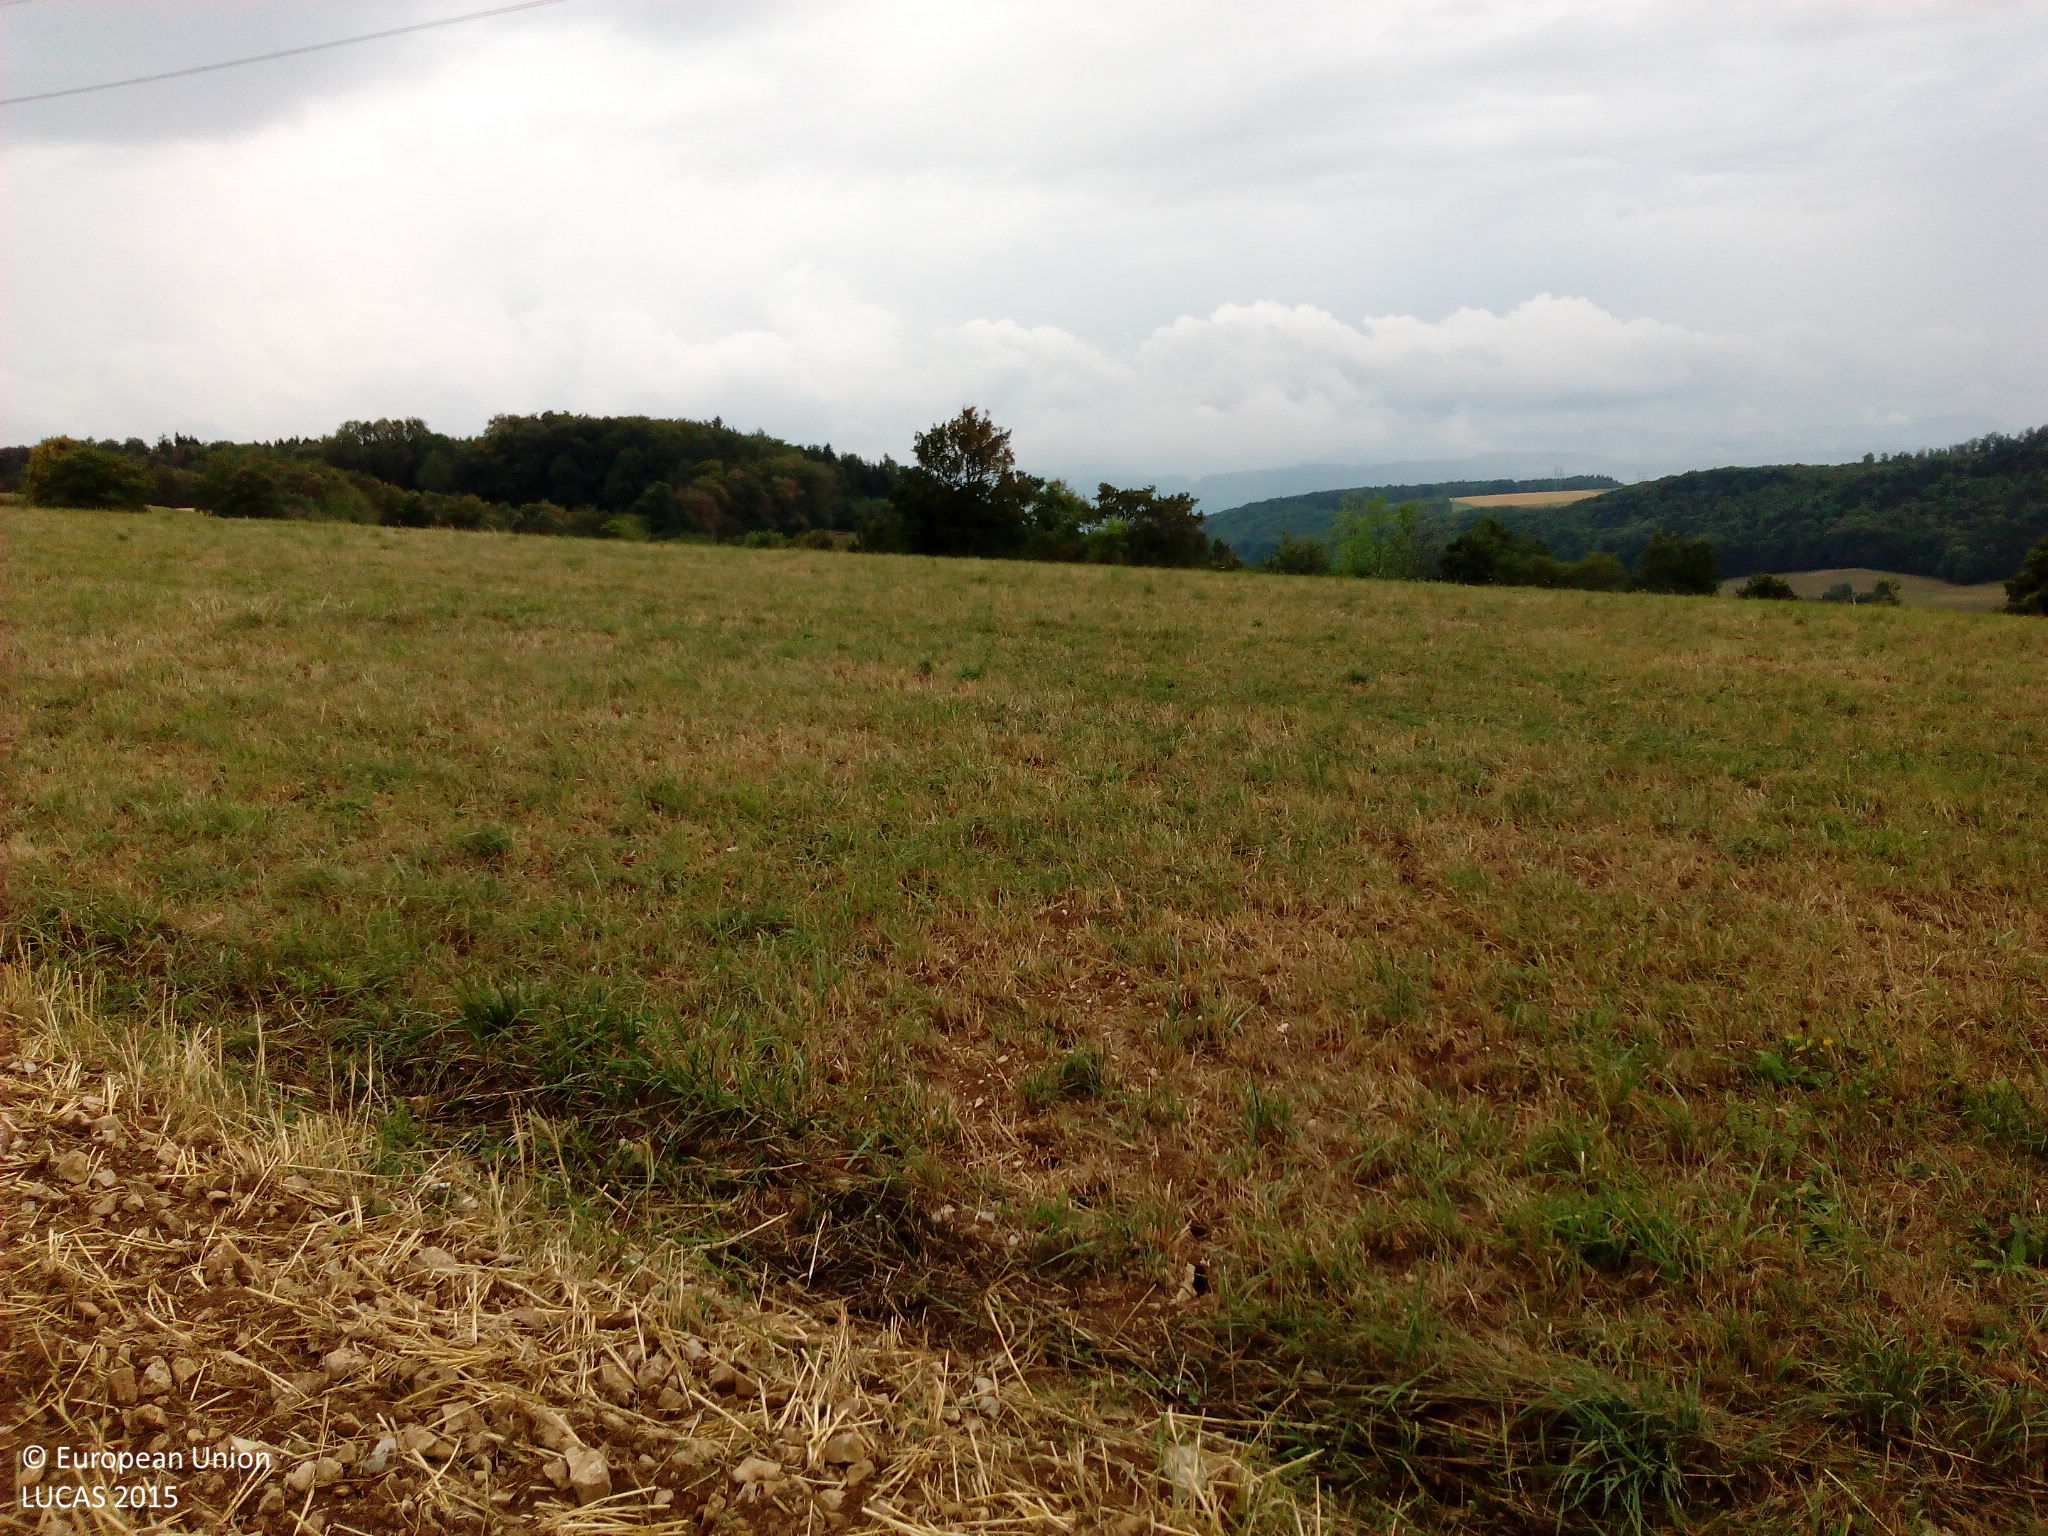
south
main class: Cropland
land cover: Common wheat
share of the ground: < 10 %
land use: Agriculture (excluding fallow land and kitchen gardens)
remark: Harvested field
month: August
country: DE
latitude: 47.6504
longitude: 8.1774
